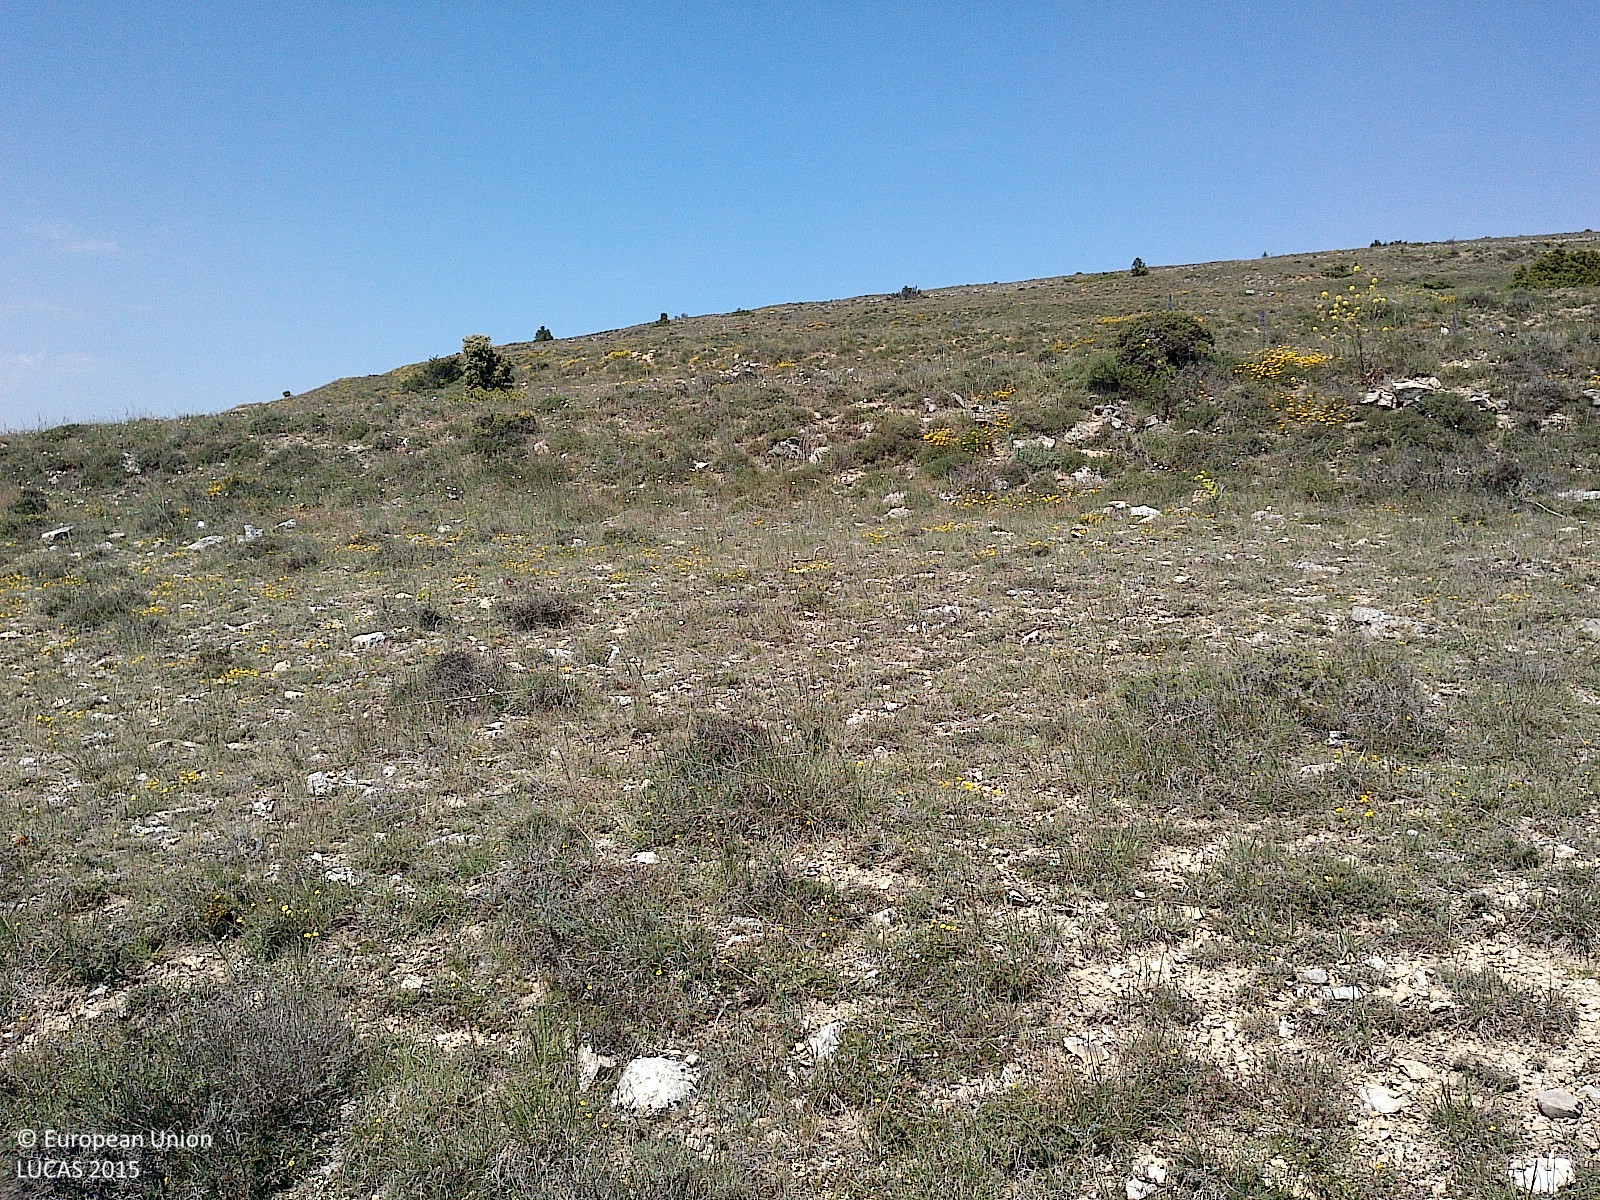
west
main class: Grassland
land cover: Grassland without tree/shrub cover
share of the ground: > 75 %
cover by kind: herbaceous plants 85 %, consolidated bare surface 10 %, shrubs 5 %
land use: Semi-natural and natural areas not in use
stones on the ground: < 10 %
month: May
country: ES
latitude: 41.8897
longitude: -2.2454
